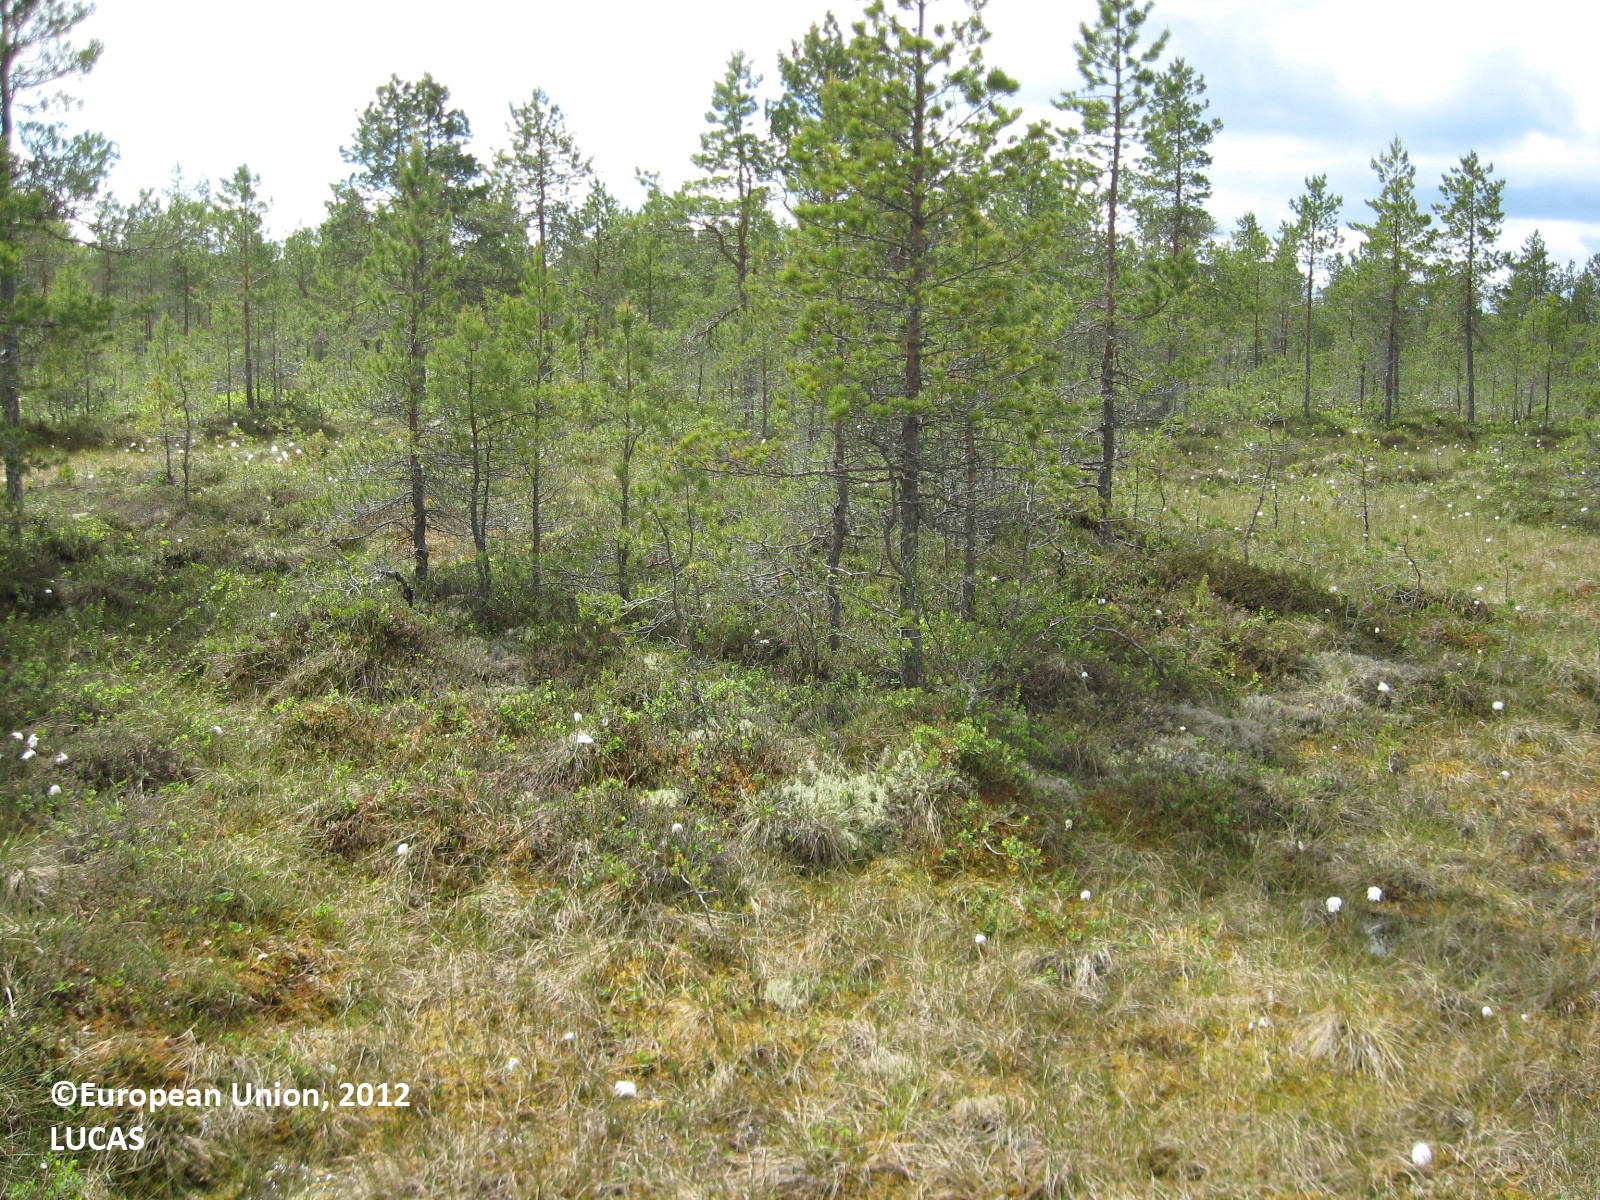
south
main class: Woodland
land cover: Pine dominated coniferous woodland
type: mire and swamp forests
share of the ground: 25 - 50 %
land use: Forestry
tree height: > 5 m
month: June
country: FI
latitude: 63.0997
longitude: 22.6729
